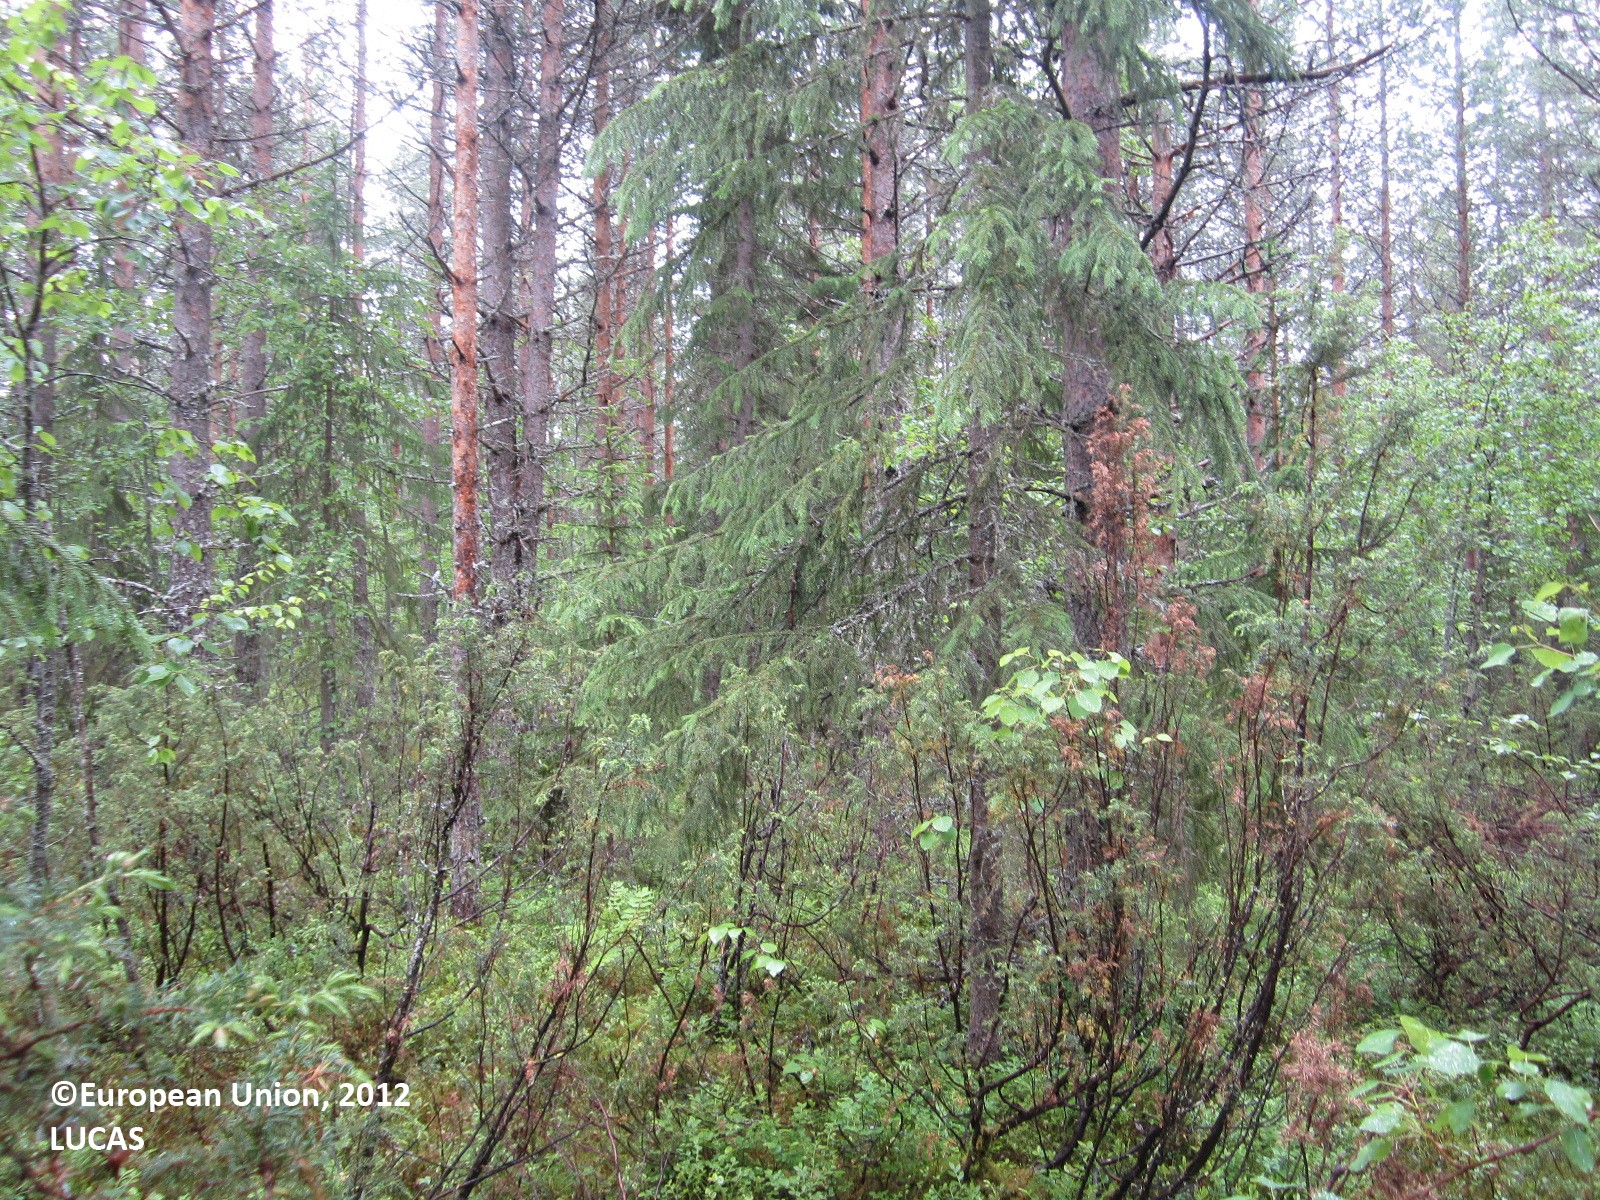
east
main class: Woodland
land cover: Pine dominated mixed woodland
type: boreal forest
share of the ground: > 75 %
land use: Forestry
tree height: > 5 m
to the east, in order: Pine dominated mixed woodland; Pine dominated coniferous woodland; Ditches and canals; Pine dominated coniferous woodland; Rock outcrops; Pine dominated coniferous woodland
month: June
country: FI
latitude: 64.5089
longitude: 29.8664
